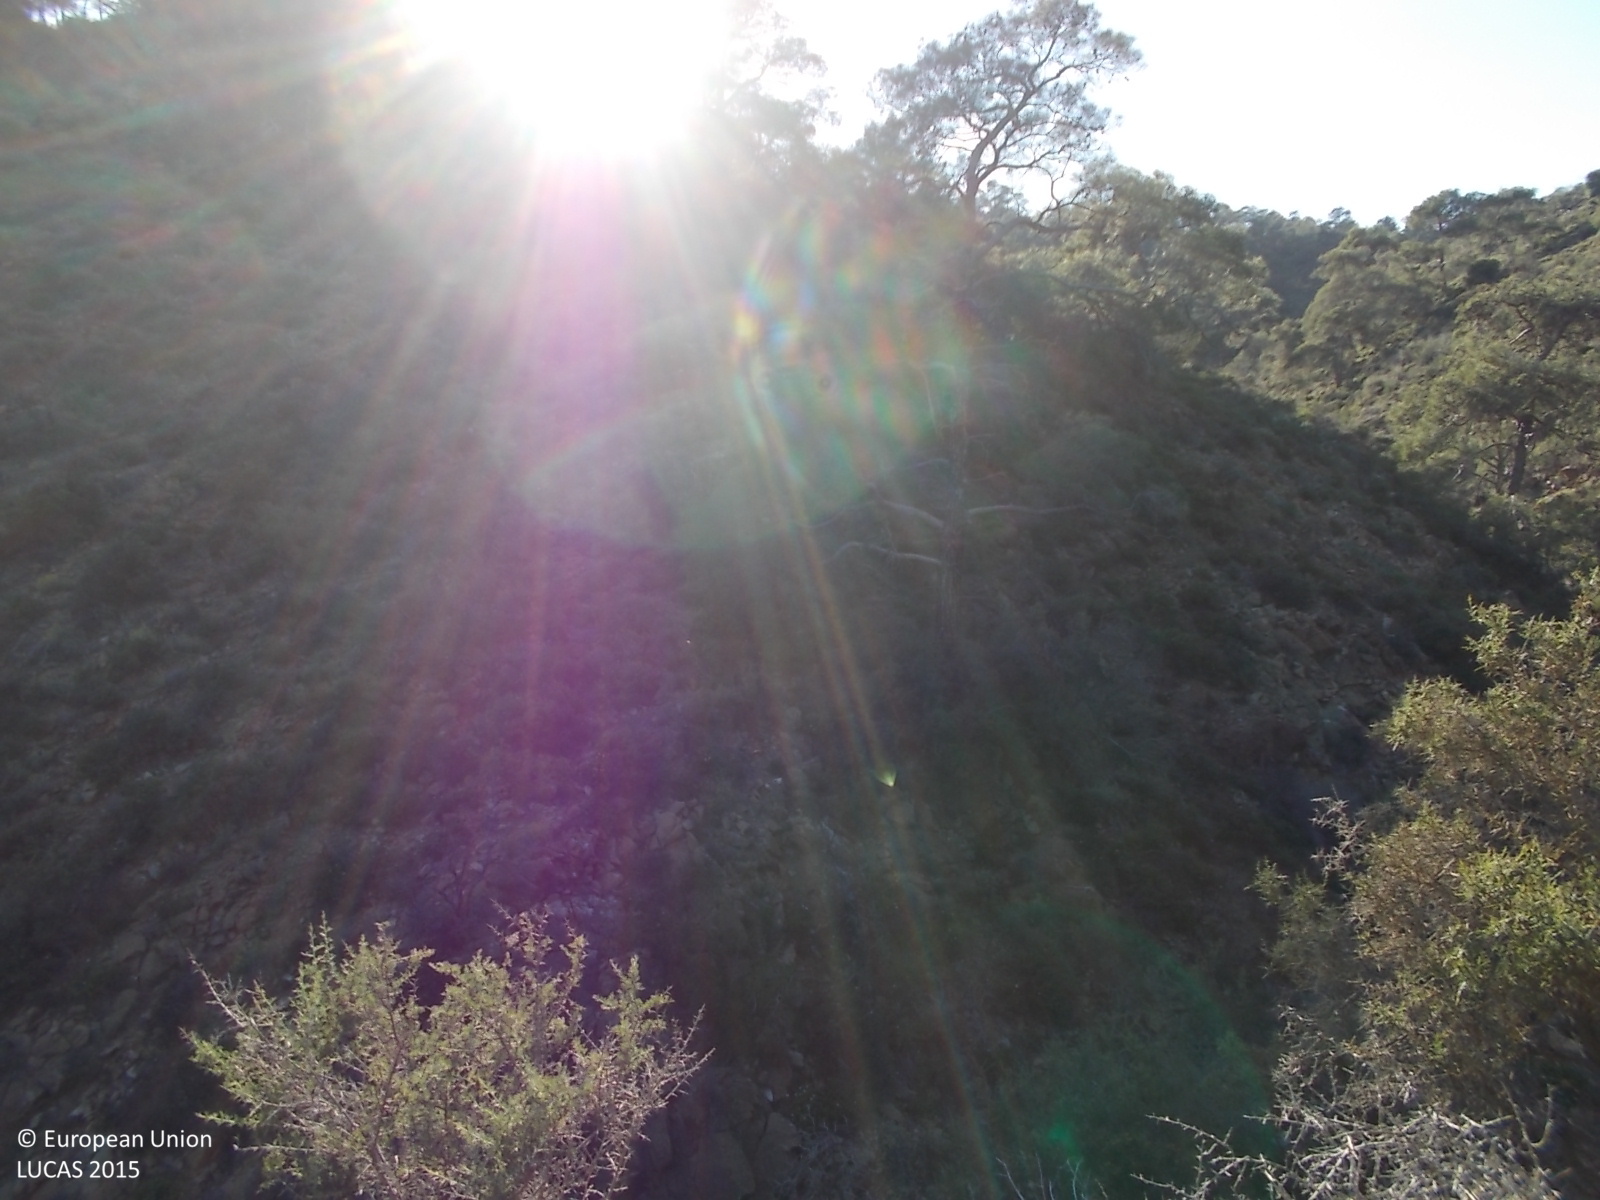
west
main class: Shrubland
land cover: Shrubland without tree cover
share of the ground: > 75 %
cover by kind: shrubs 95 %, herbaceous plants 5 %
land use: Semi-natural and natural areas not in use
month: April
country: CY
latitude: 34.7793
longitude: 33.1302
